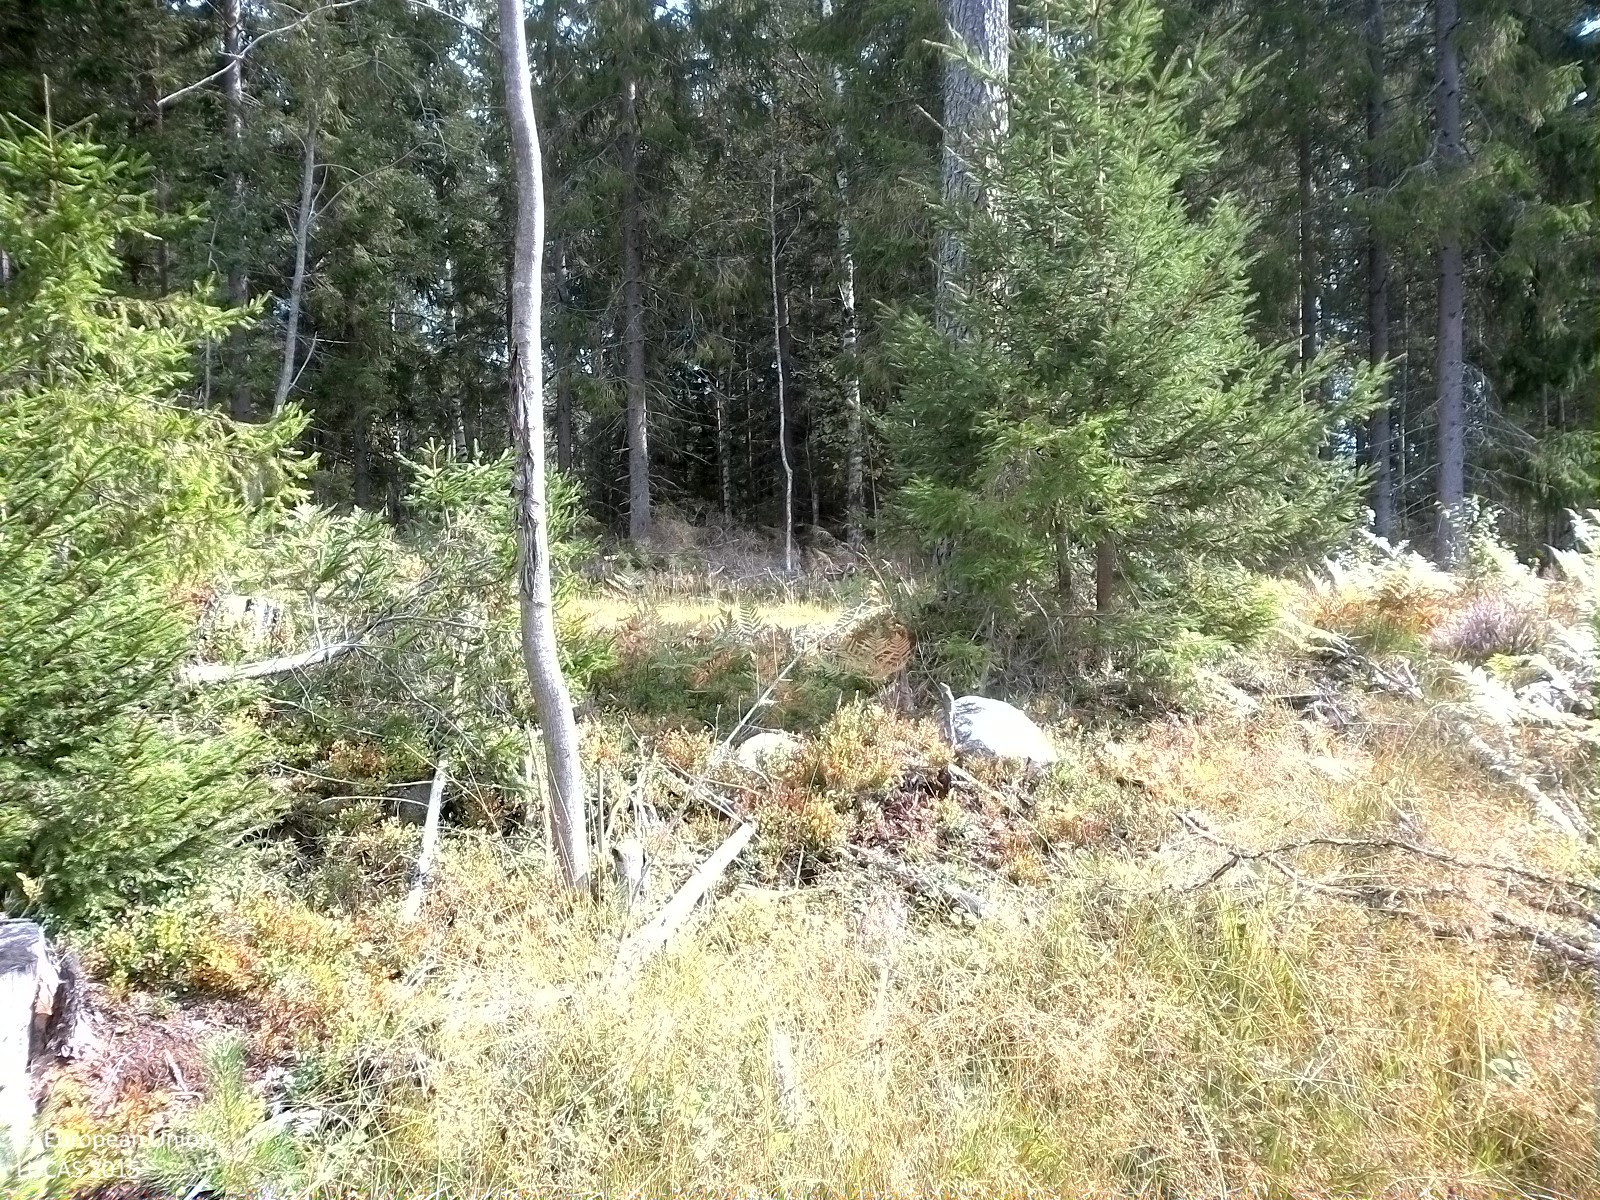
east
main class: Woodland
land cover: Spruce dominated mixed woodland
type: boreal forest
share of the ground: 25 - 50 %
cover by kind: herbaceous plants 45 %, coniferous forest trees 20 %, broadleaved forest trees 15 %, shrubs 10 %, lichens and mosses 10 %
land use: Forestry
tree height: < 5 m
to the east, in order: Spruce dominated mixed woodland; Paved roads, cycling and walking lanes; Spruce dominated coniferous woodland; Dry stone walls; Grassland without tree/shrub cover; Broadleaved woodland; Fences; Grassland without tree/shrub cover
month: August
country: SE
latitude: 58.8456
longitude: 15.5214
